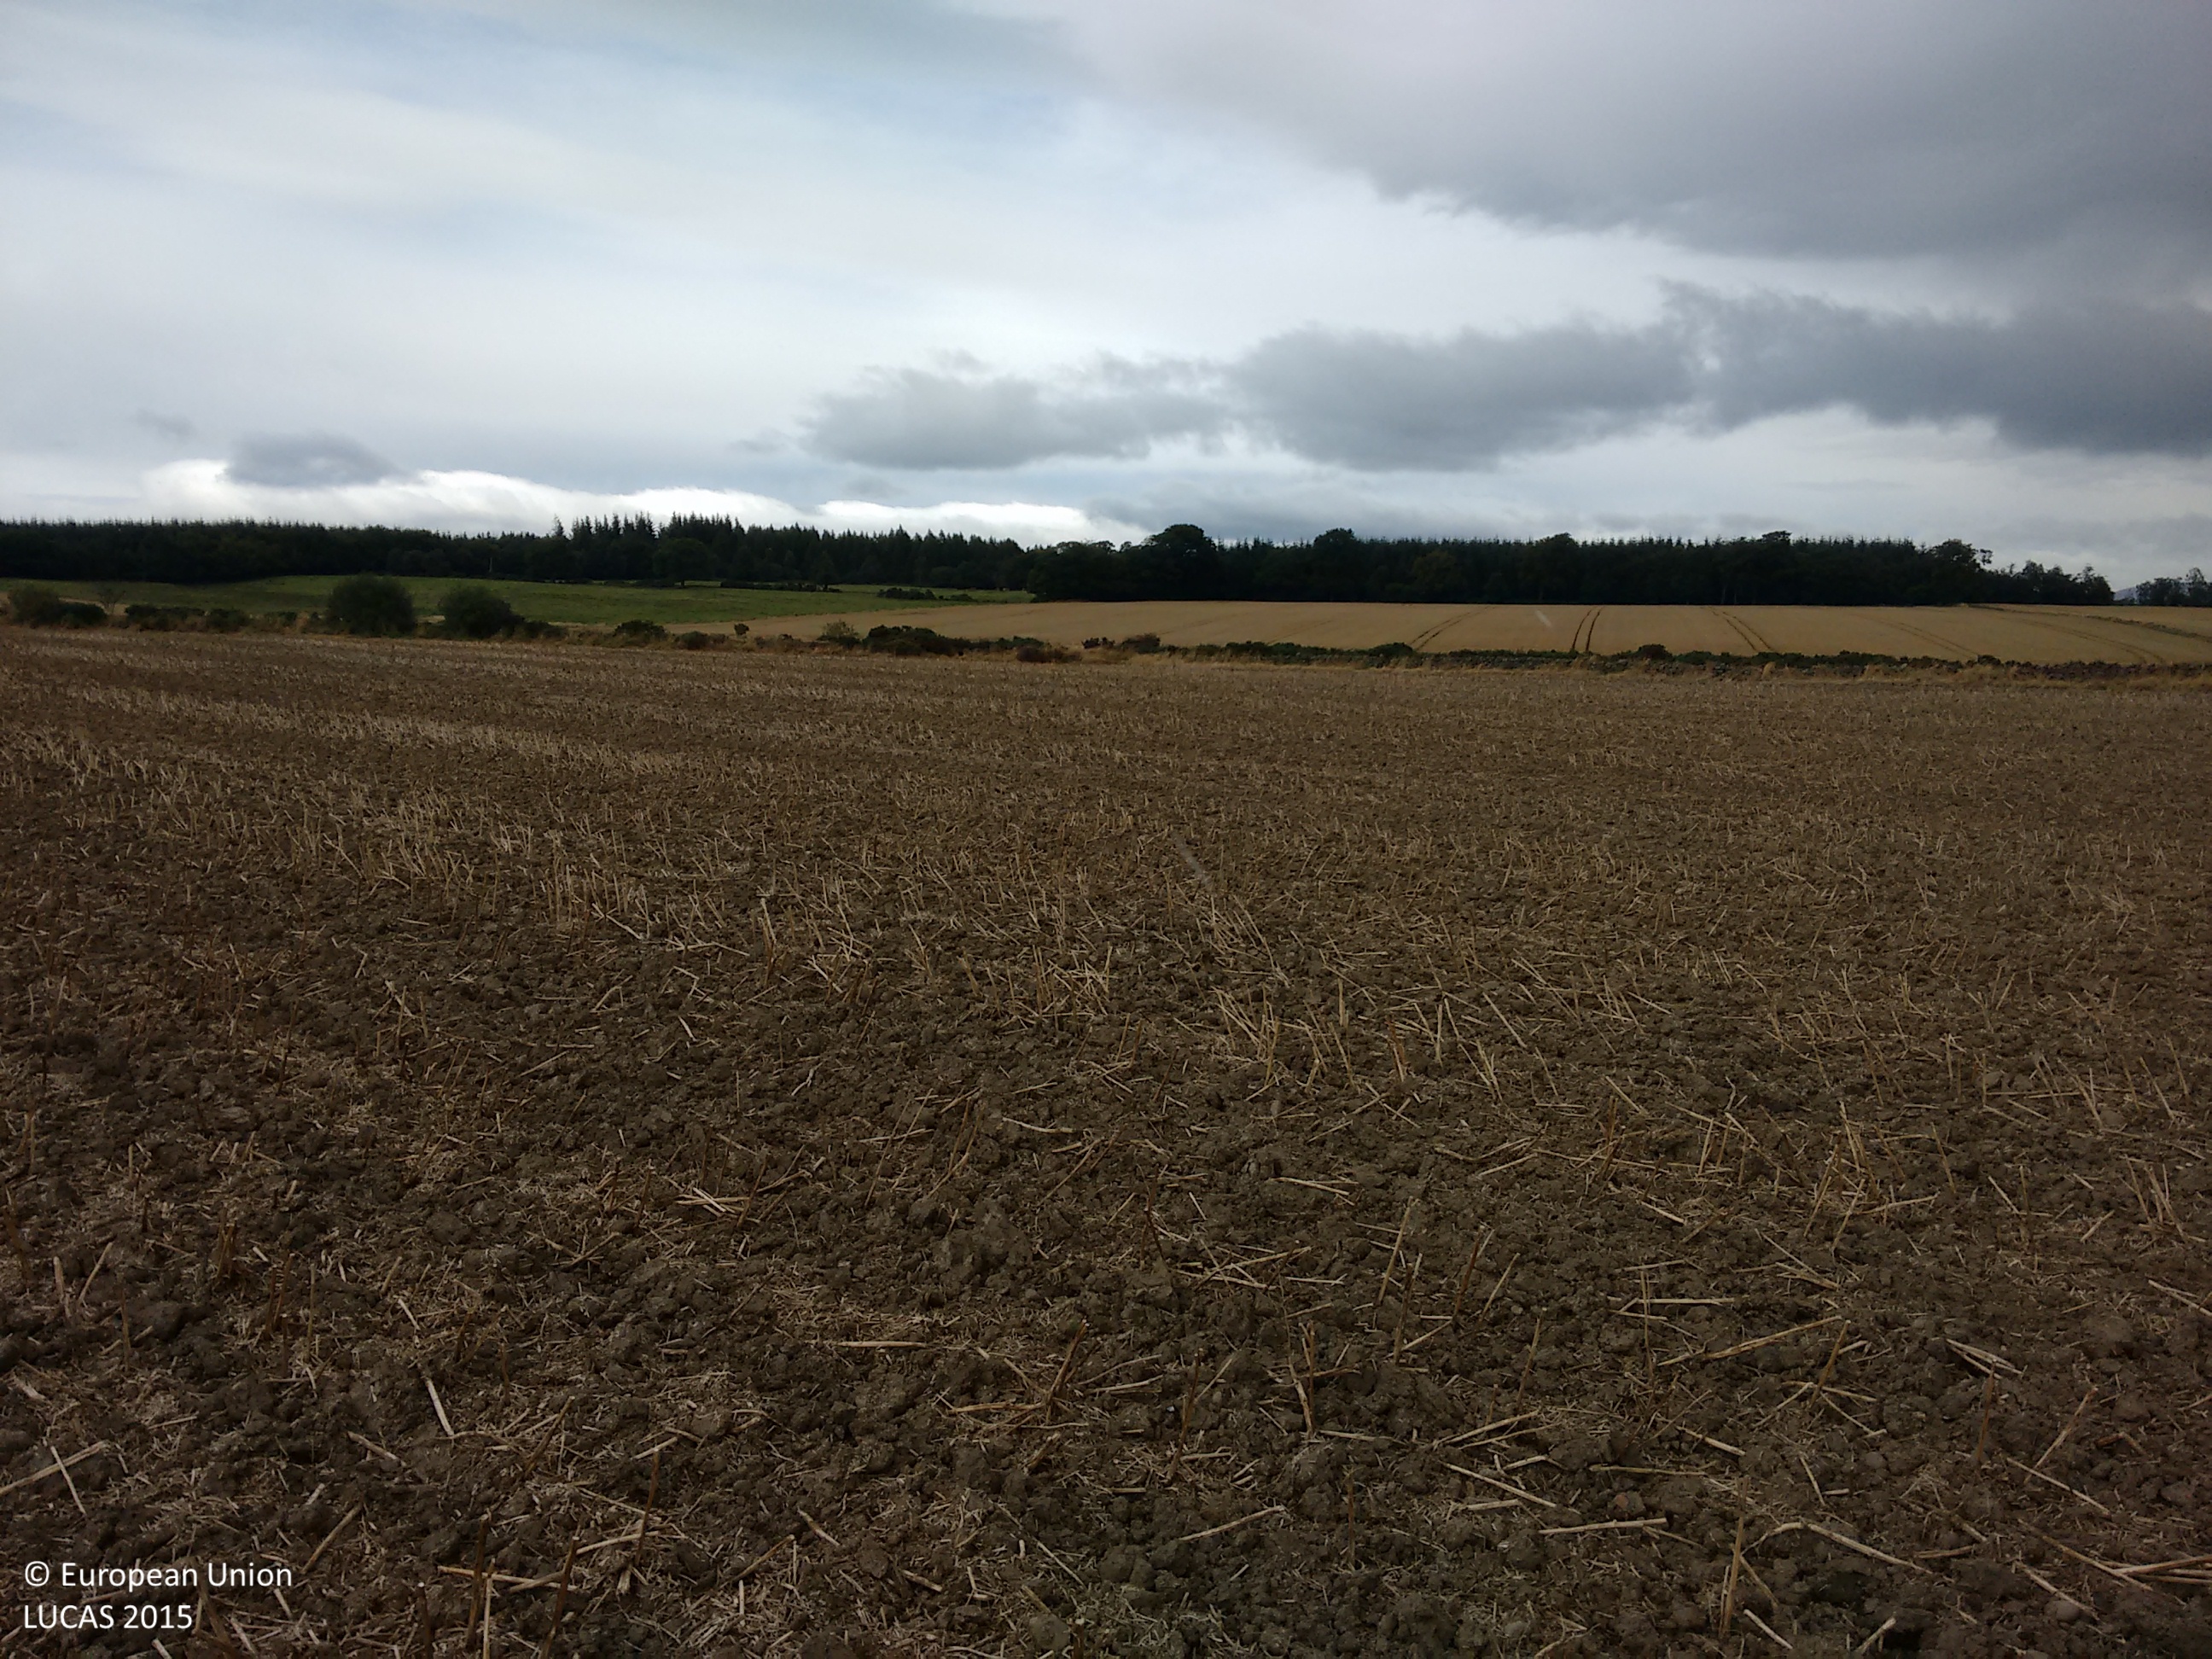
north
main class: Cropland
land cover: Rape and turnip rape
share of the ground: < 10 %
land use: Agriculture (excluding fallow land and kitchen gardens)
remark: Harvested field
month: September
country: GB
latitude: 56.0326
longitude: -3.8699
